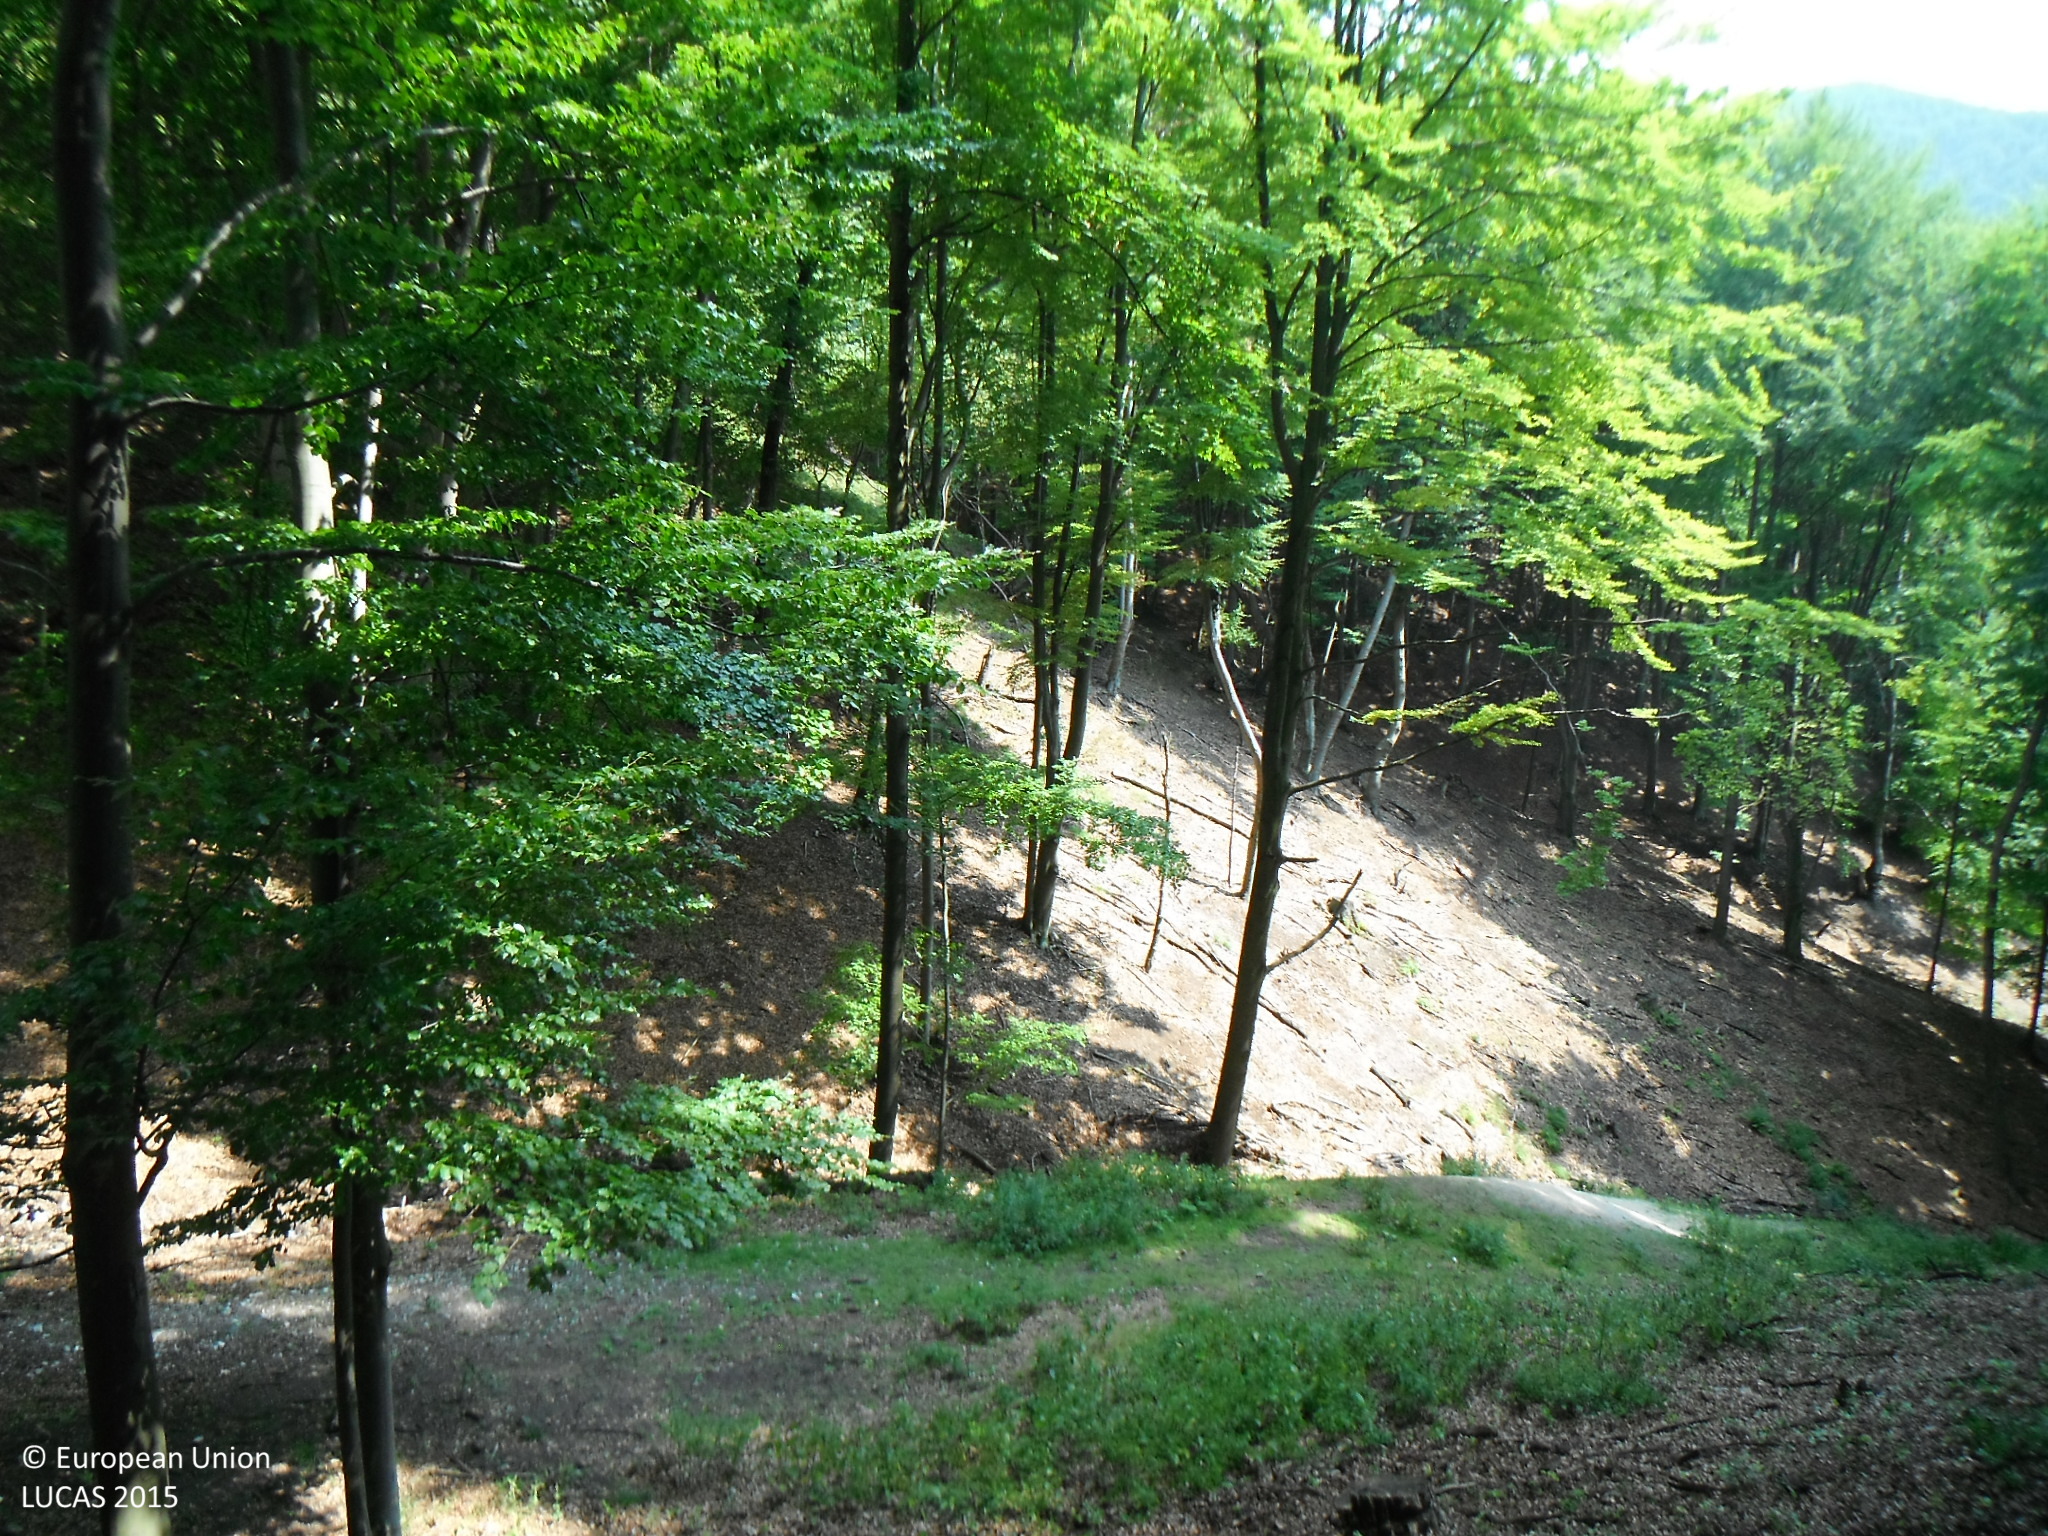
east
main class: Woodland
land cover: Broadleaved woodland
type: mountainous beech forest
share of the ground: > 75 %
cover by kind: broadleaved forest trees 60 %, unconsolidated bare surface 30 %, herbaceous plants 10 %
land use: Forestry
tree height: > 5 m
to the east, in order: Broadleaved woodland; Rivers and streams; Broadleaved woodland; Grassland with sparse tree/shrub cover; Broadleaved woodland
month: August
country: SK
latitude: 48.9725
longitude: 18.3638
